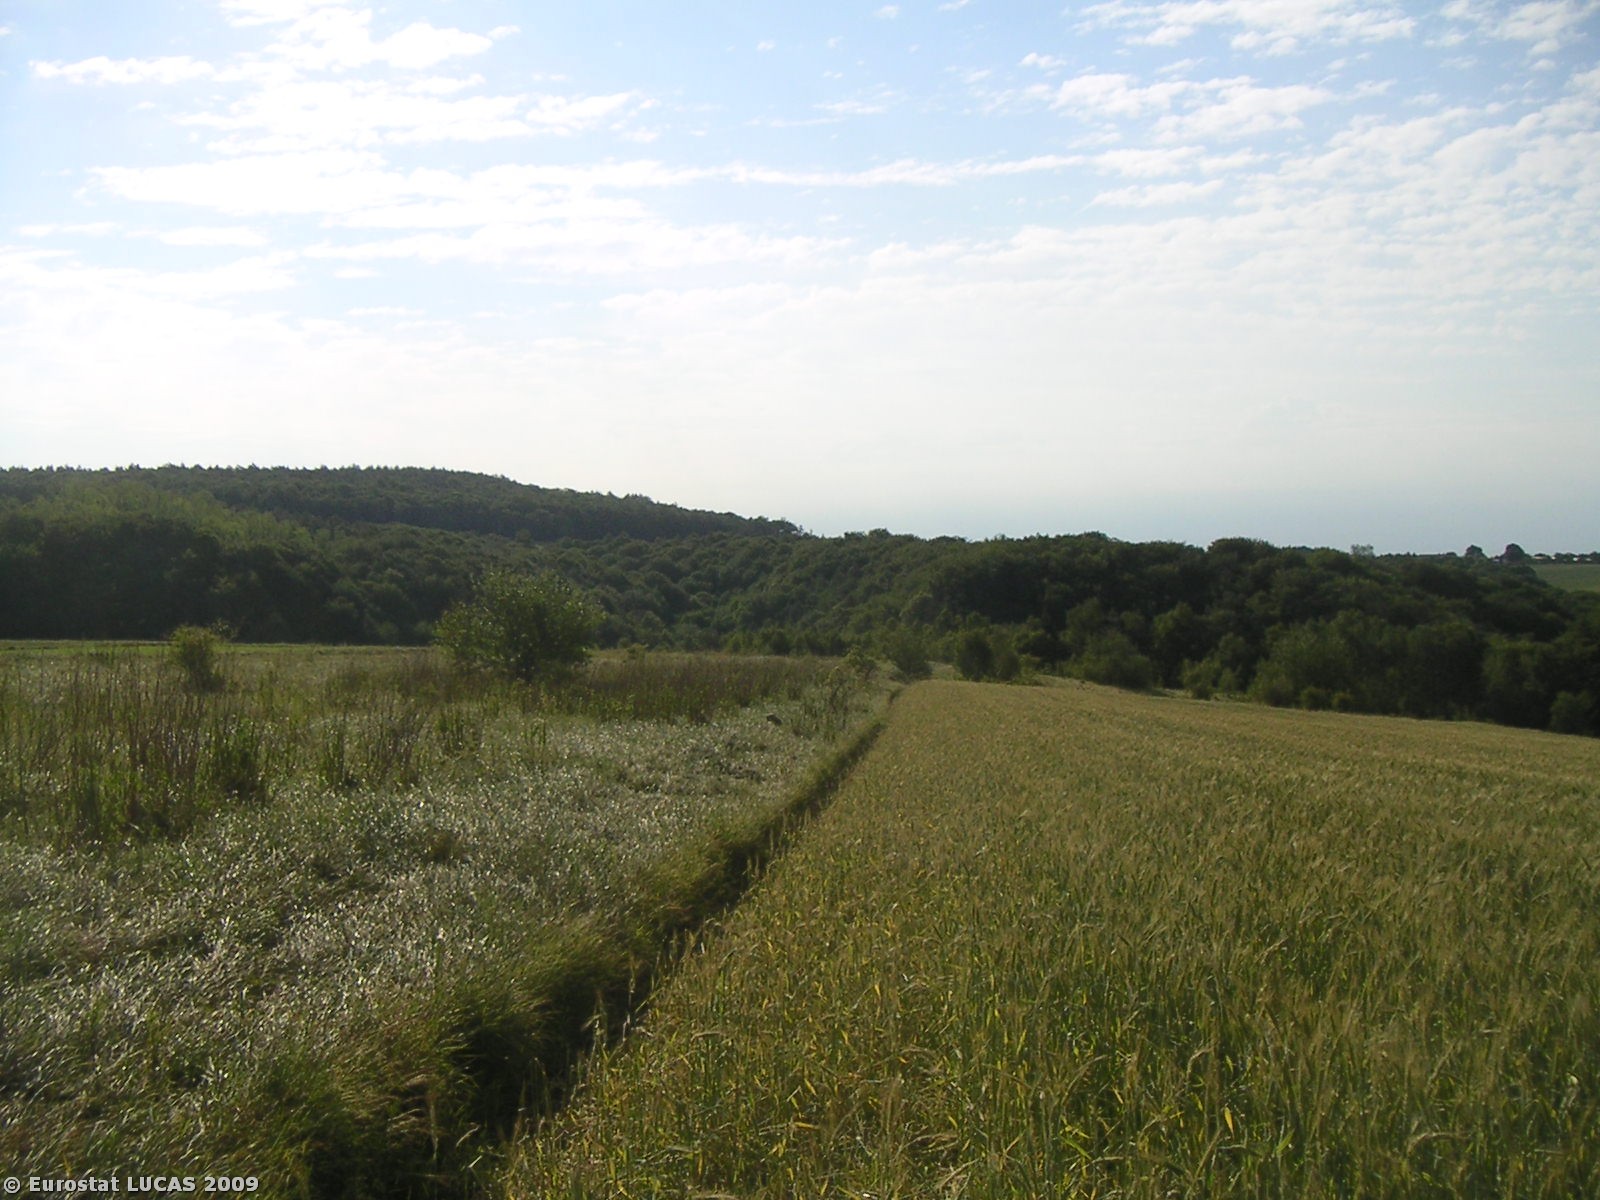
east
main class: Cropland
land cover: Triticale
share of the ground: > 75 %
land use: Agriculture (excluding fallow land and kitchen gardens)
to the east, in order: Triticale; Grassland with sparse tree/shrub cover; Spontaneously vegetated surfaces
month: June
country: PL
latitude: 50.1632
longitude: 19.7589
